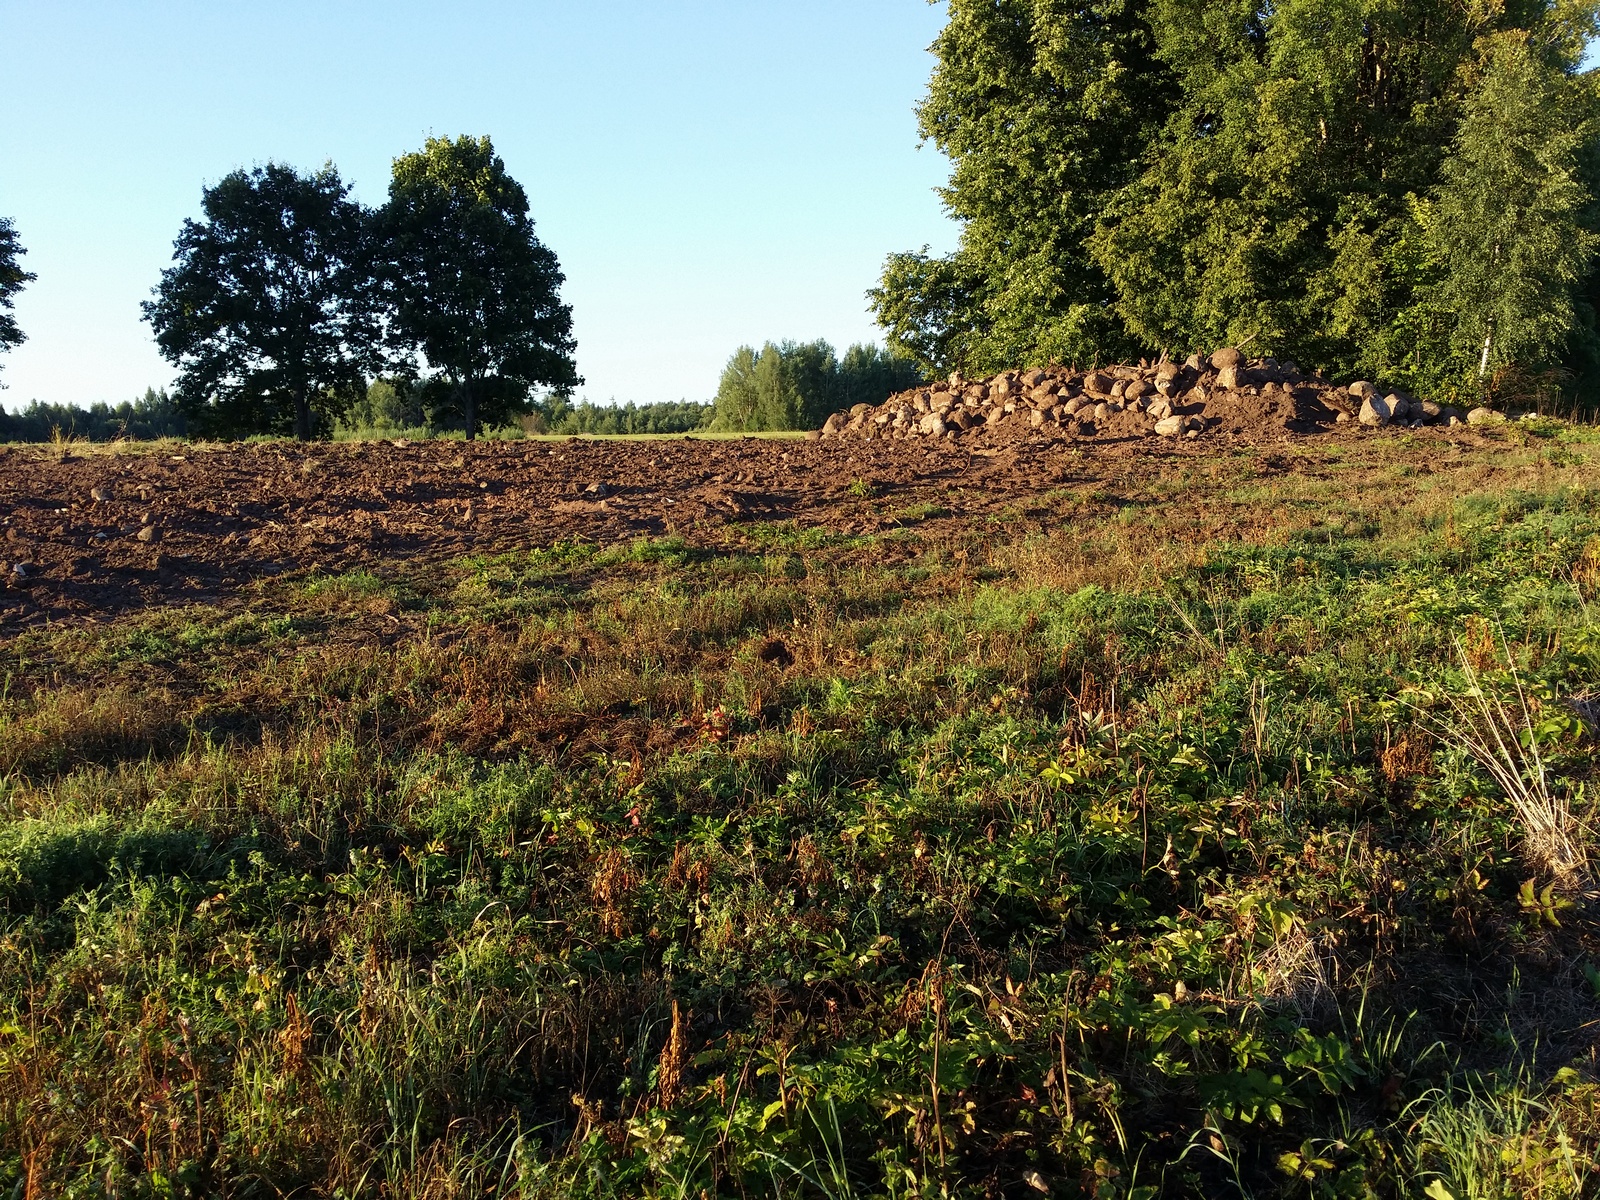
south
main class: Grassland
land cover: Grassland without tree/shrub cover
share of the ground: > 75 %
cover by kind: herbaceous plants 90 %, unconsolidated bare surface 10 %
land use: Agriculture (excluding fallow land and kitchen gardens)
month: August
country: LV
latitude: 57.0776
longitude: 27.6177
